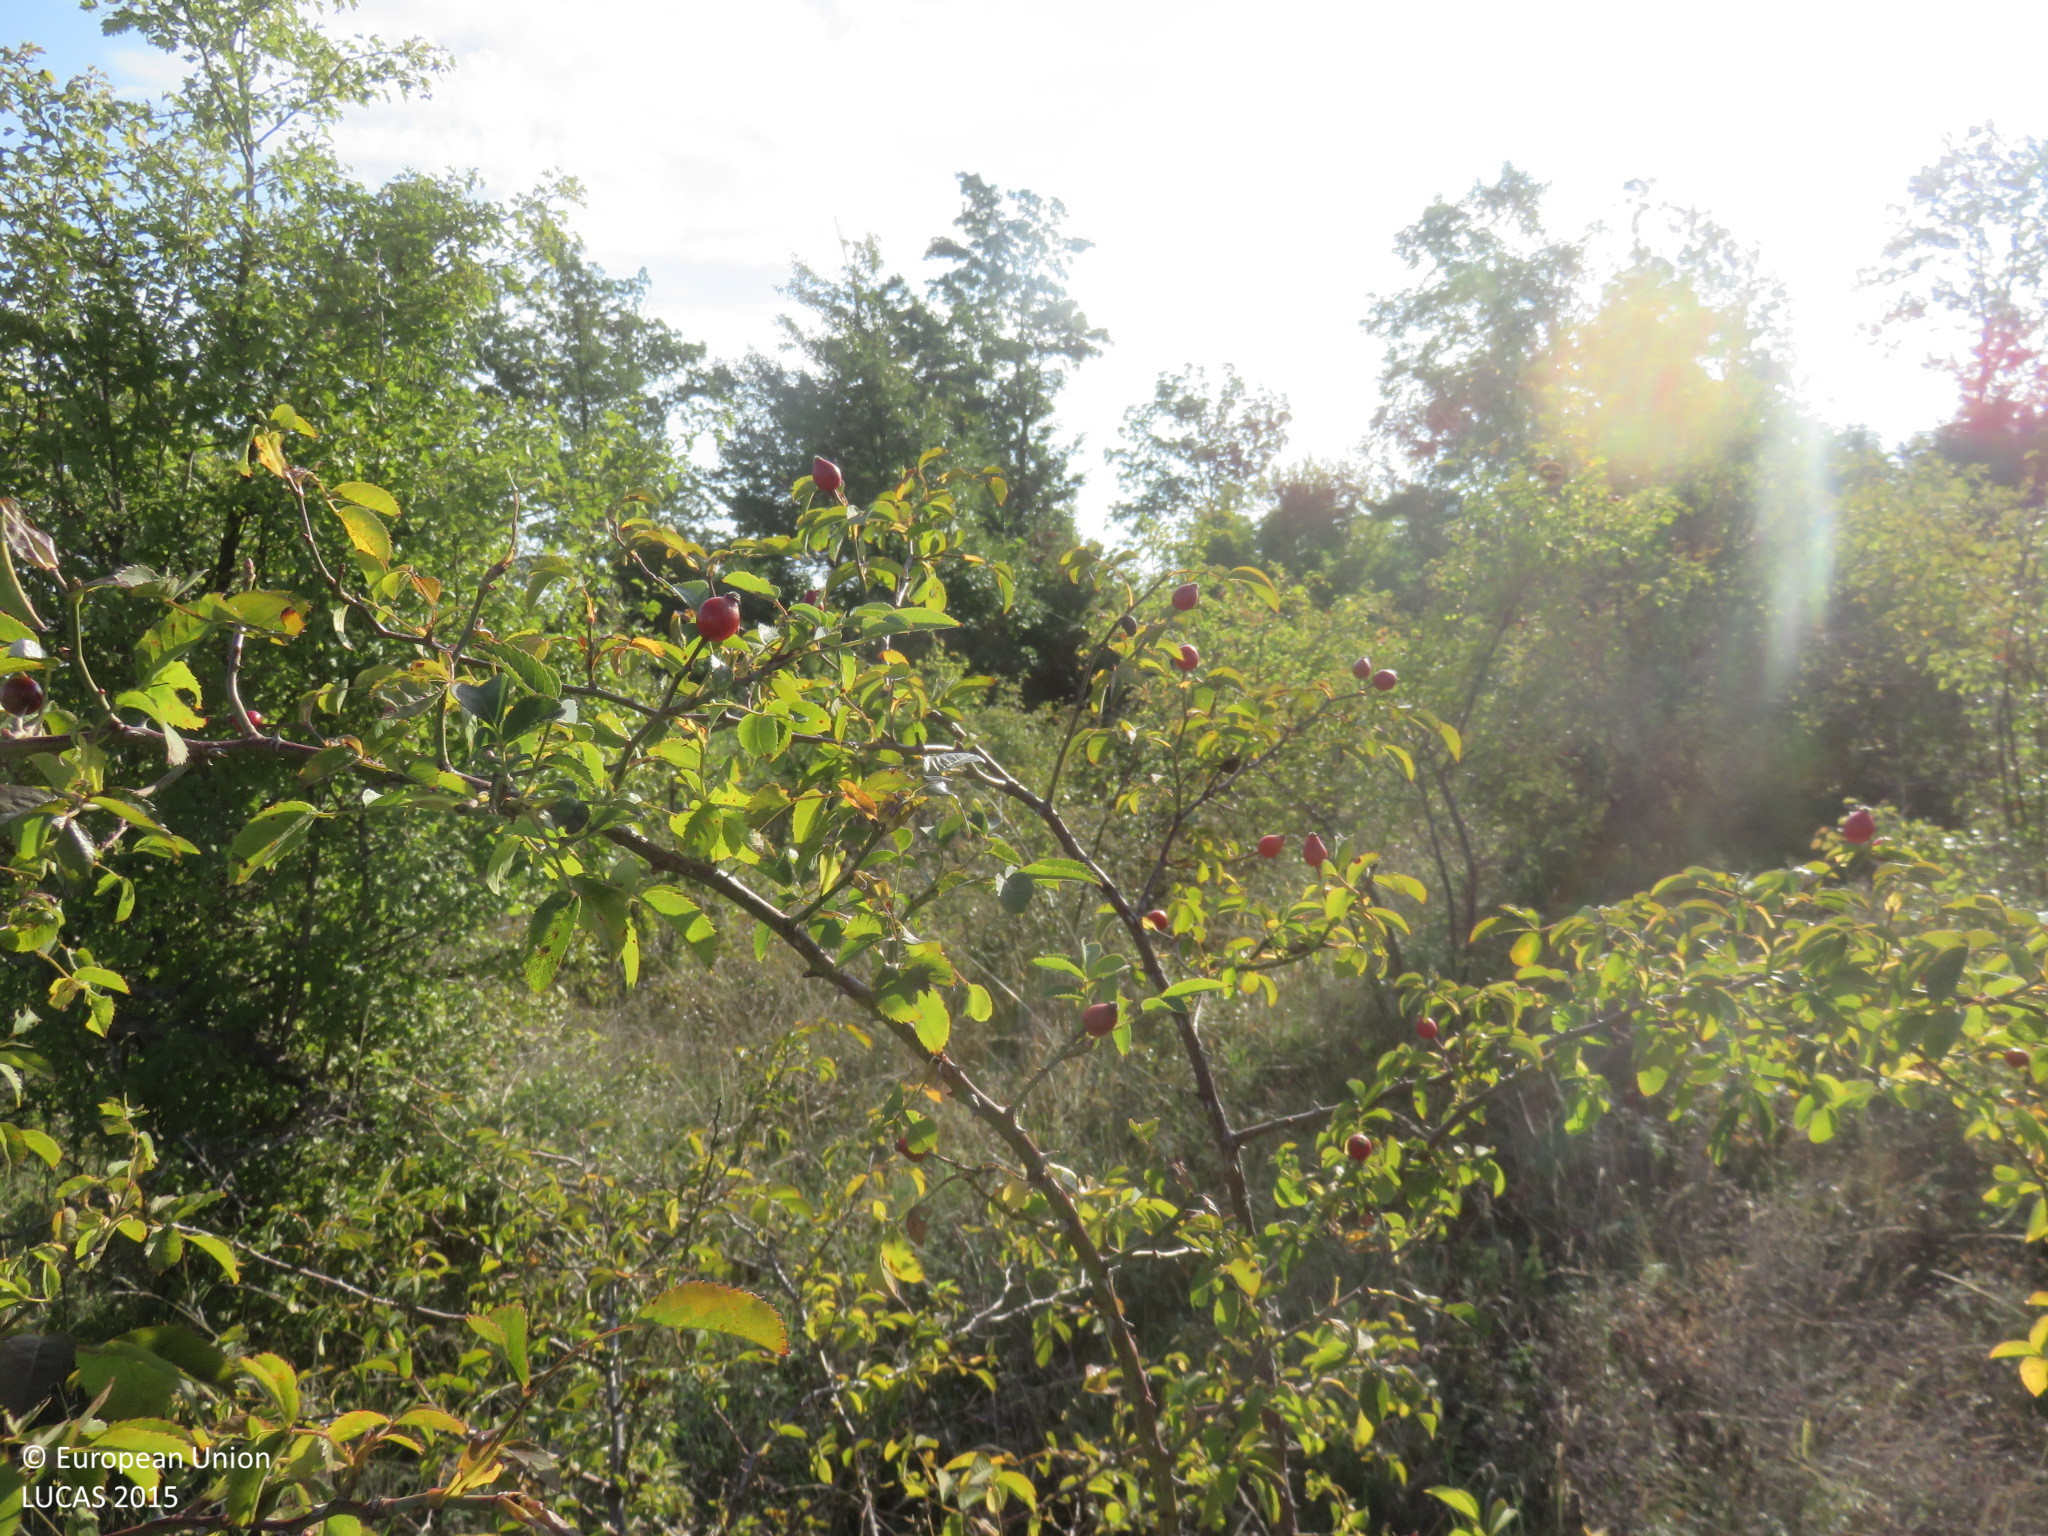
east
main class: Grassland
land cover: Grassland with sparse tree/shrub cover
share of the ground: > 75 %
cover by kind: herbaceous plants 90 %, broadleaved forest trees 5 %, shrubs 5 %
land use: Semi-natural and natural areas not in use
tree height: < 5 m
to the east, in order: Grassland with sparse tree/shrub cover; Broadleaved woodland
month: October
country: BG
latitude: 43.0610
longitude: 24.9350
